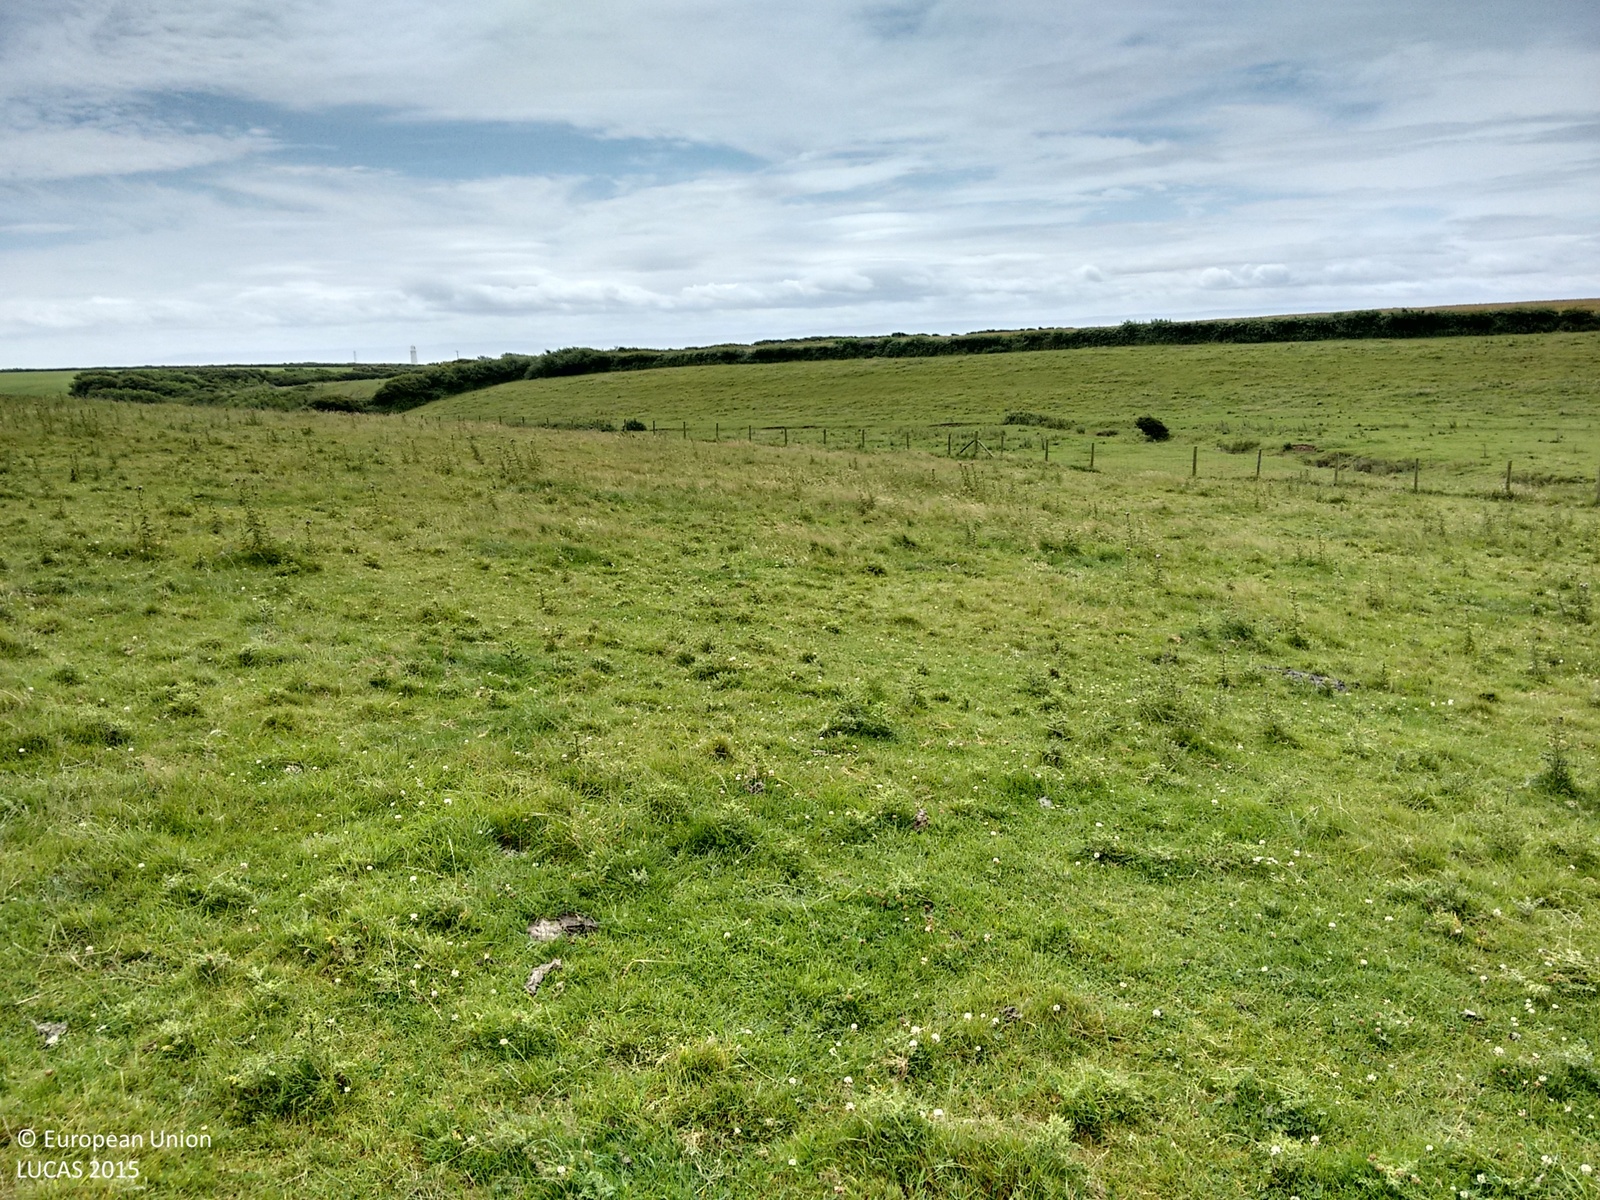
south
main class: Grassland
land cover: Grassland without tree/shrub cover
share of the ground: > 75 %
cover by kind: herbaceous plants 100 %
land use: Agriculture (excluding fallow land and kitchen gardens)
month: July
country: GB
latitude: 51.4125
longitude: -3.5576
